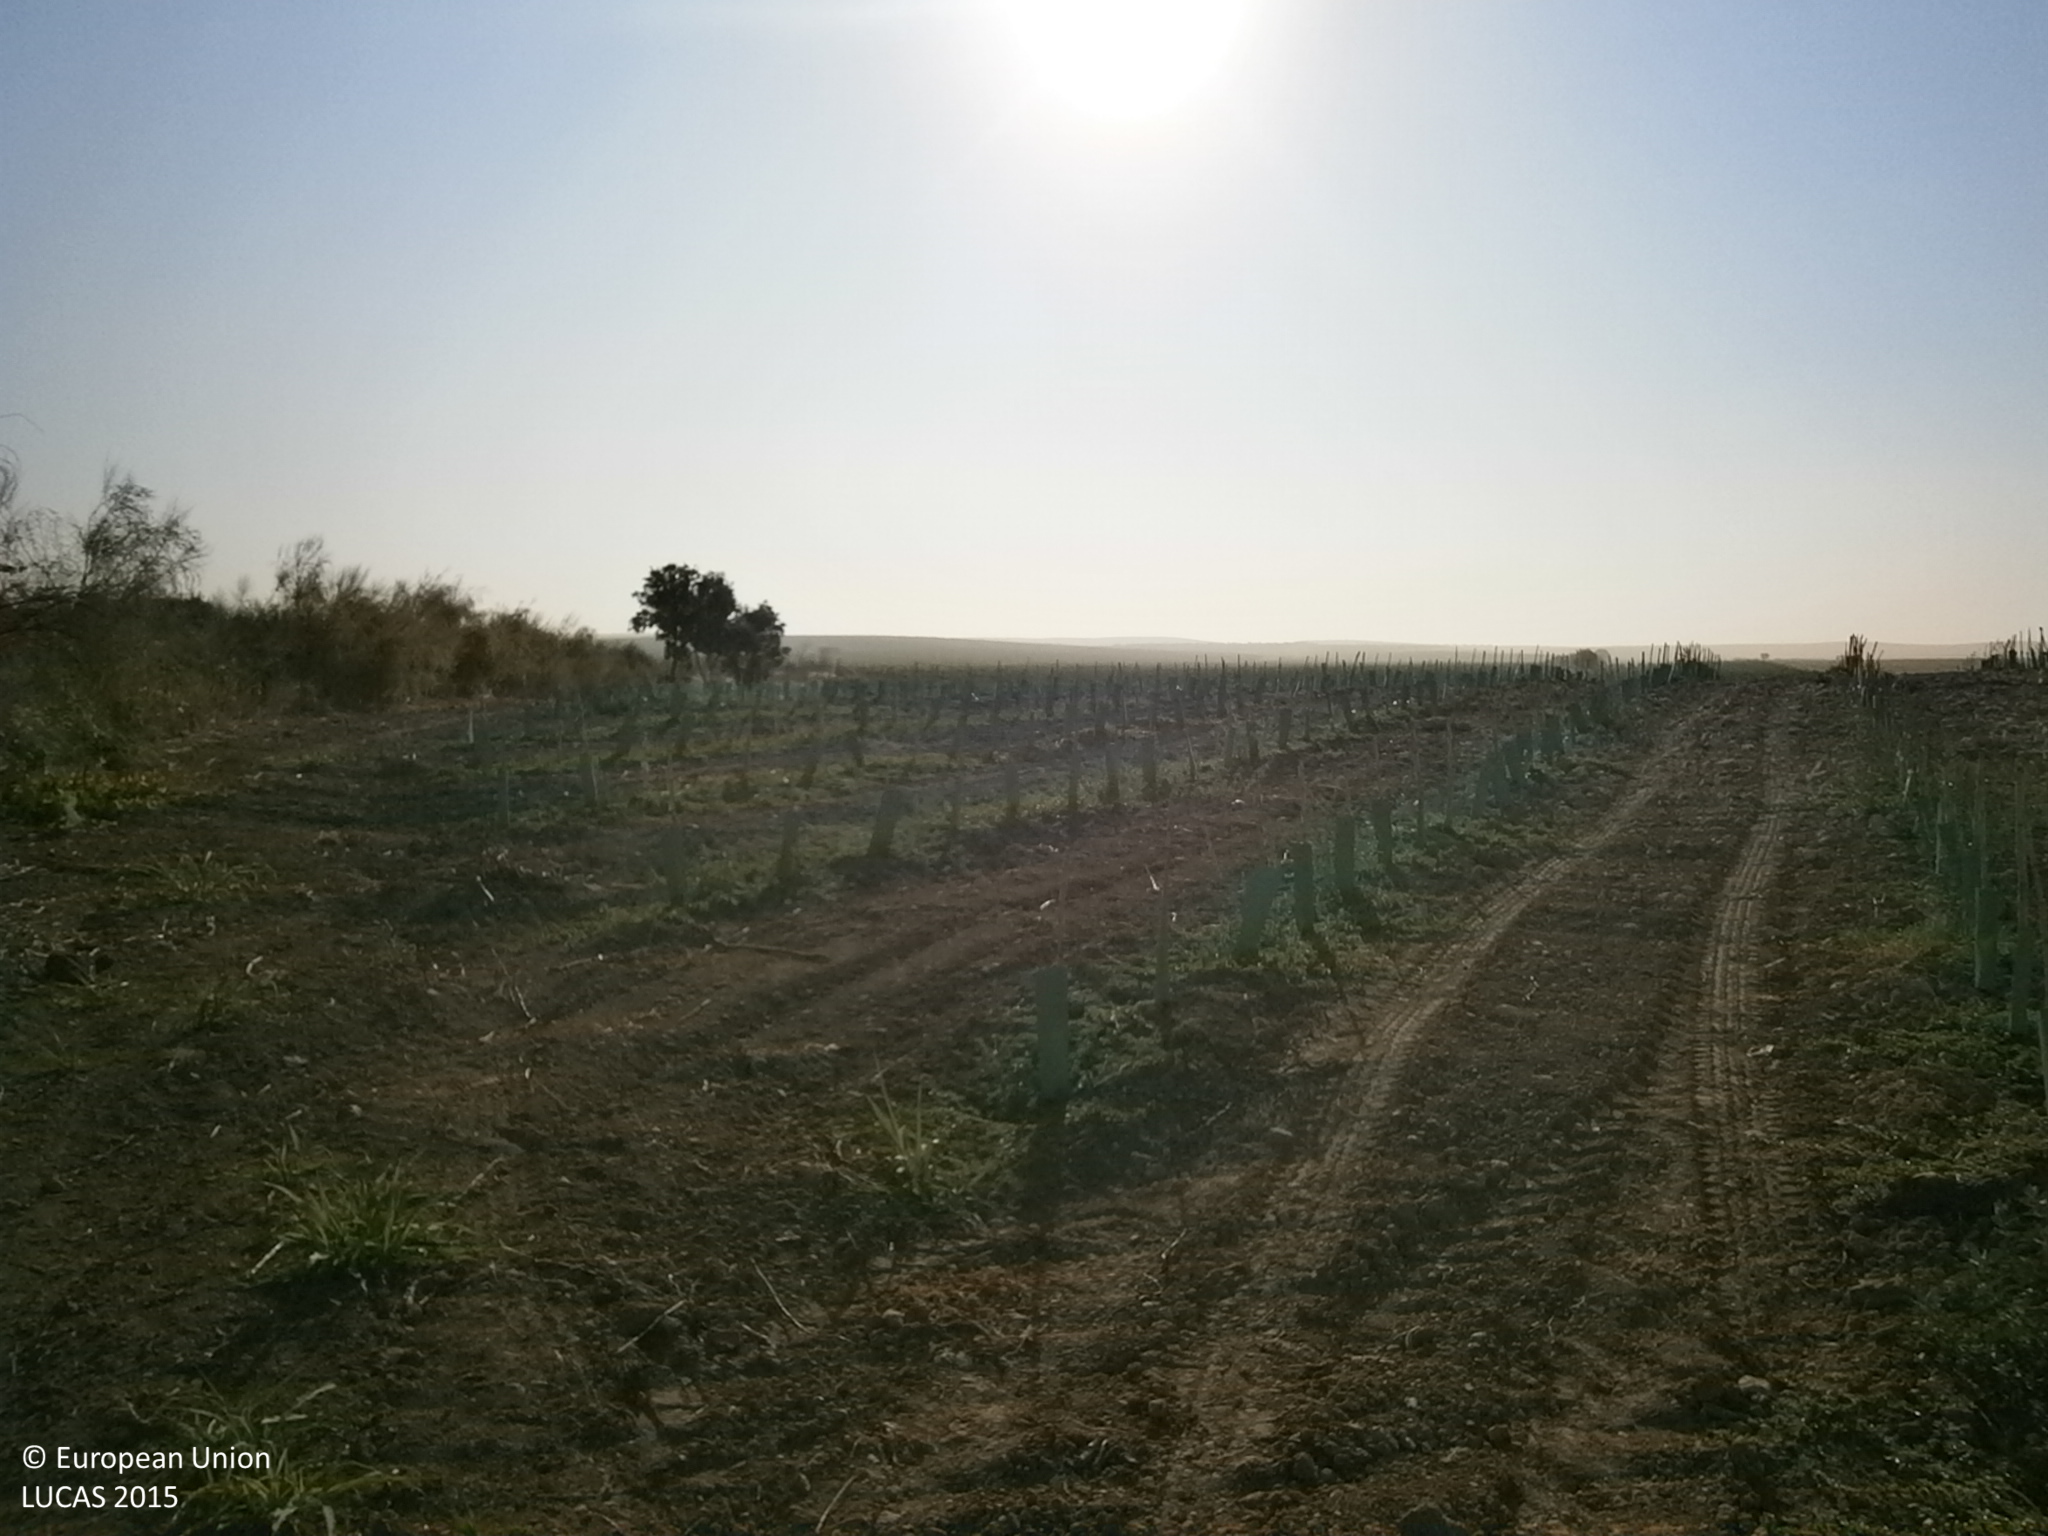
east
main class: Cropland
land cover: Vineyards
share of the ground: 25 - 50 %
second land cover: Spontaneously vegetated surfaces
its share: 25 - 50 %
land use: Agriculture (excluding fallow land and kitchen gardens)
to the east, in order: Vineyards; Spontaneously vegetated surfaces; Other root crops; Rivers and streams; Vineyards
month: June
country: ES
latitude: 38.7722
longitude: -6.7879
